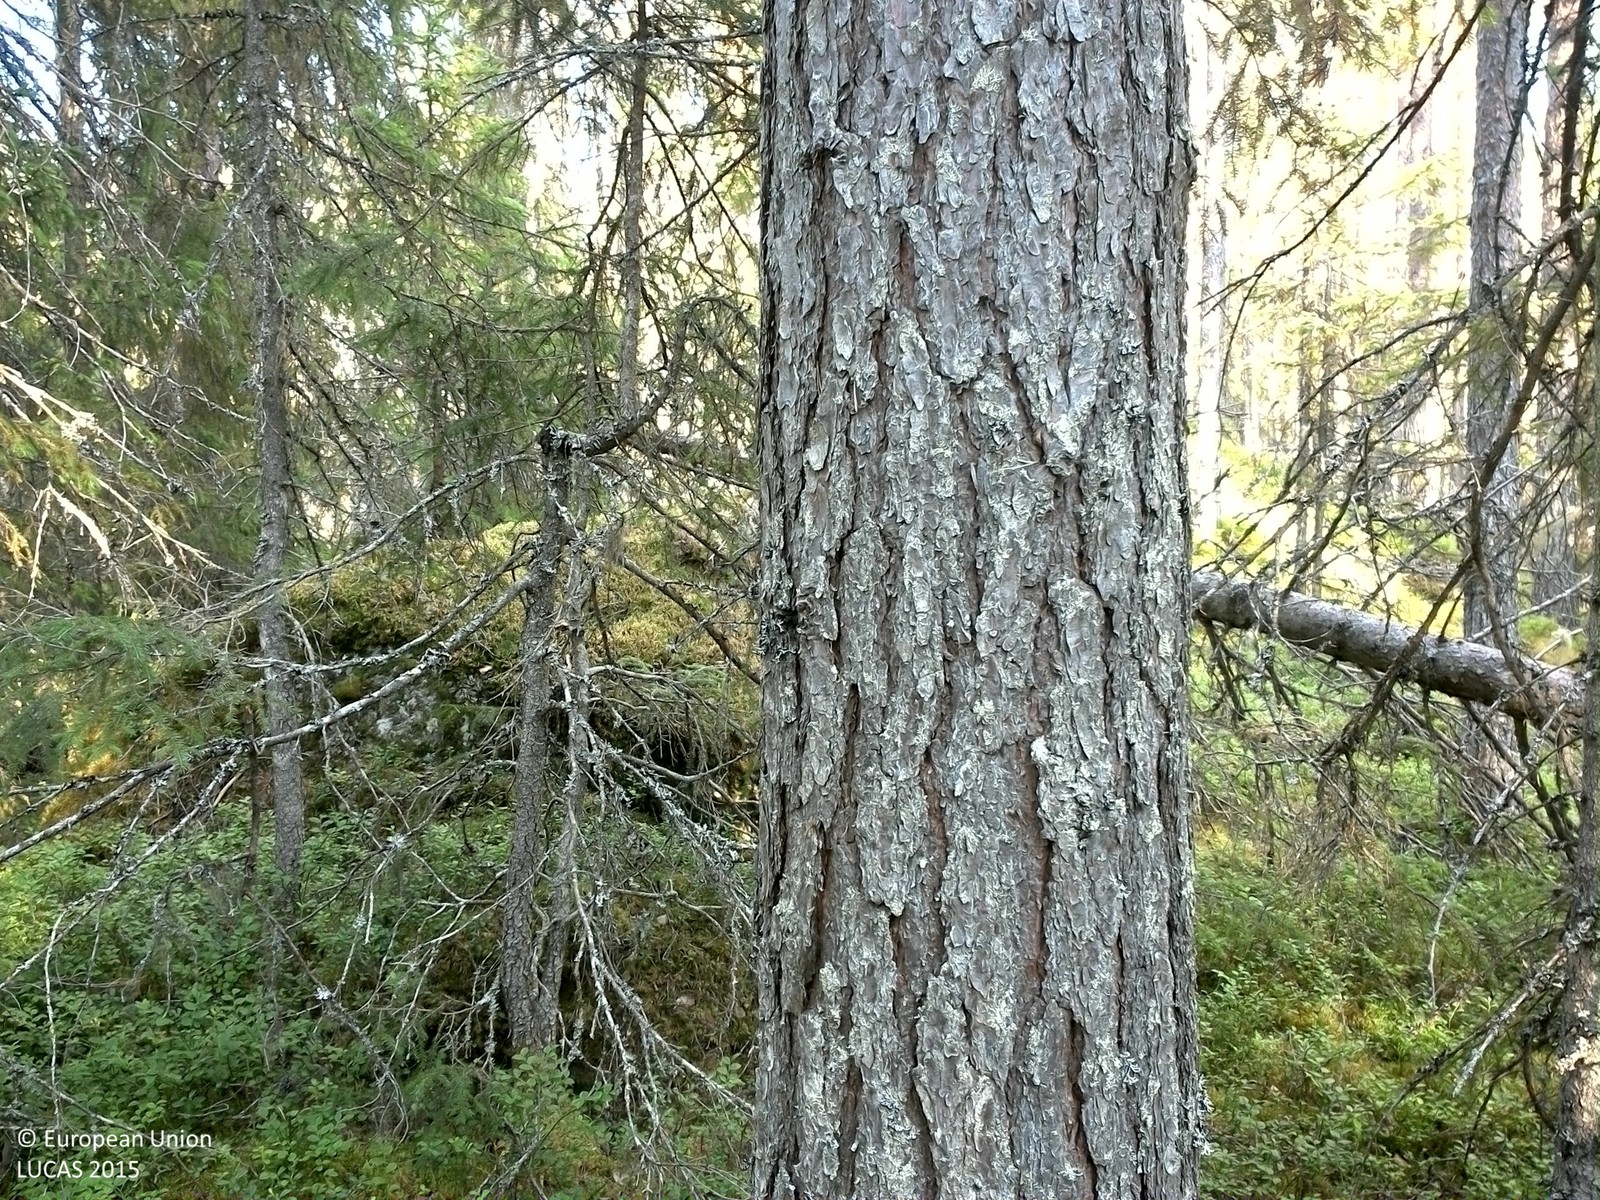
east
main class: Woodland
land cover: Pine dominated coniferous woodland
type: boreal forest
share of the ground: 50 - 75 %
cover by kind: coniferous forest trees 50 %, shrubs 35 %, lichens and mosses 15 %
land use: Forestry
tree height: > 5 m
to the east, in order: Pine dominated coniferous woodland; Peatbogs; Pine dominated coniferous woodland
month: August
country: SE
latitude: 63.6361
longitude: 16.3714
